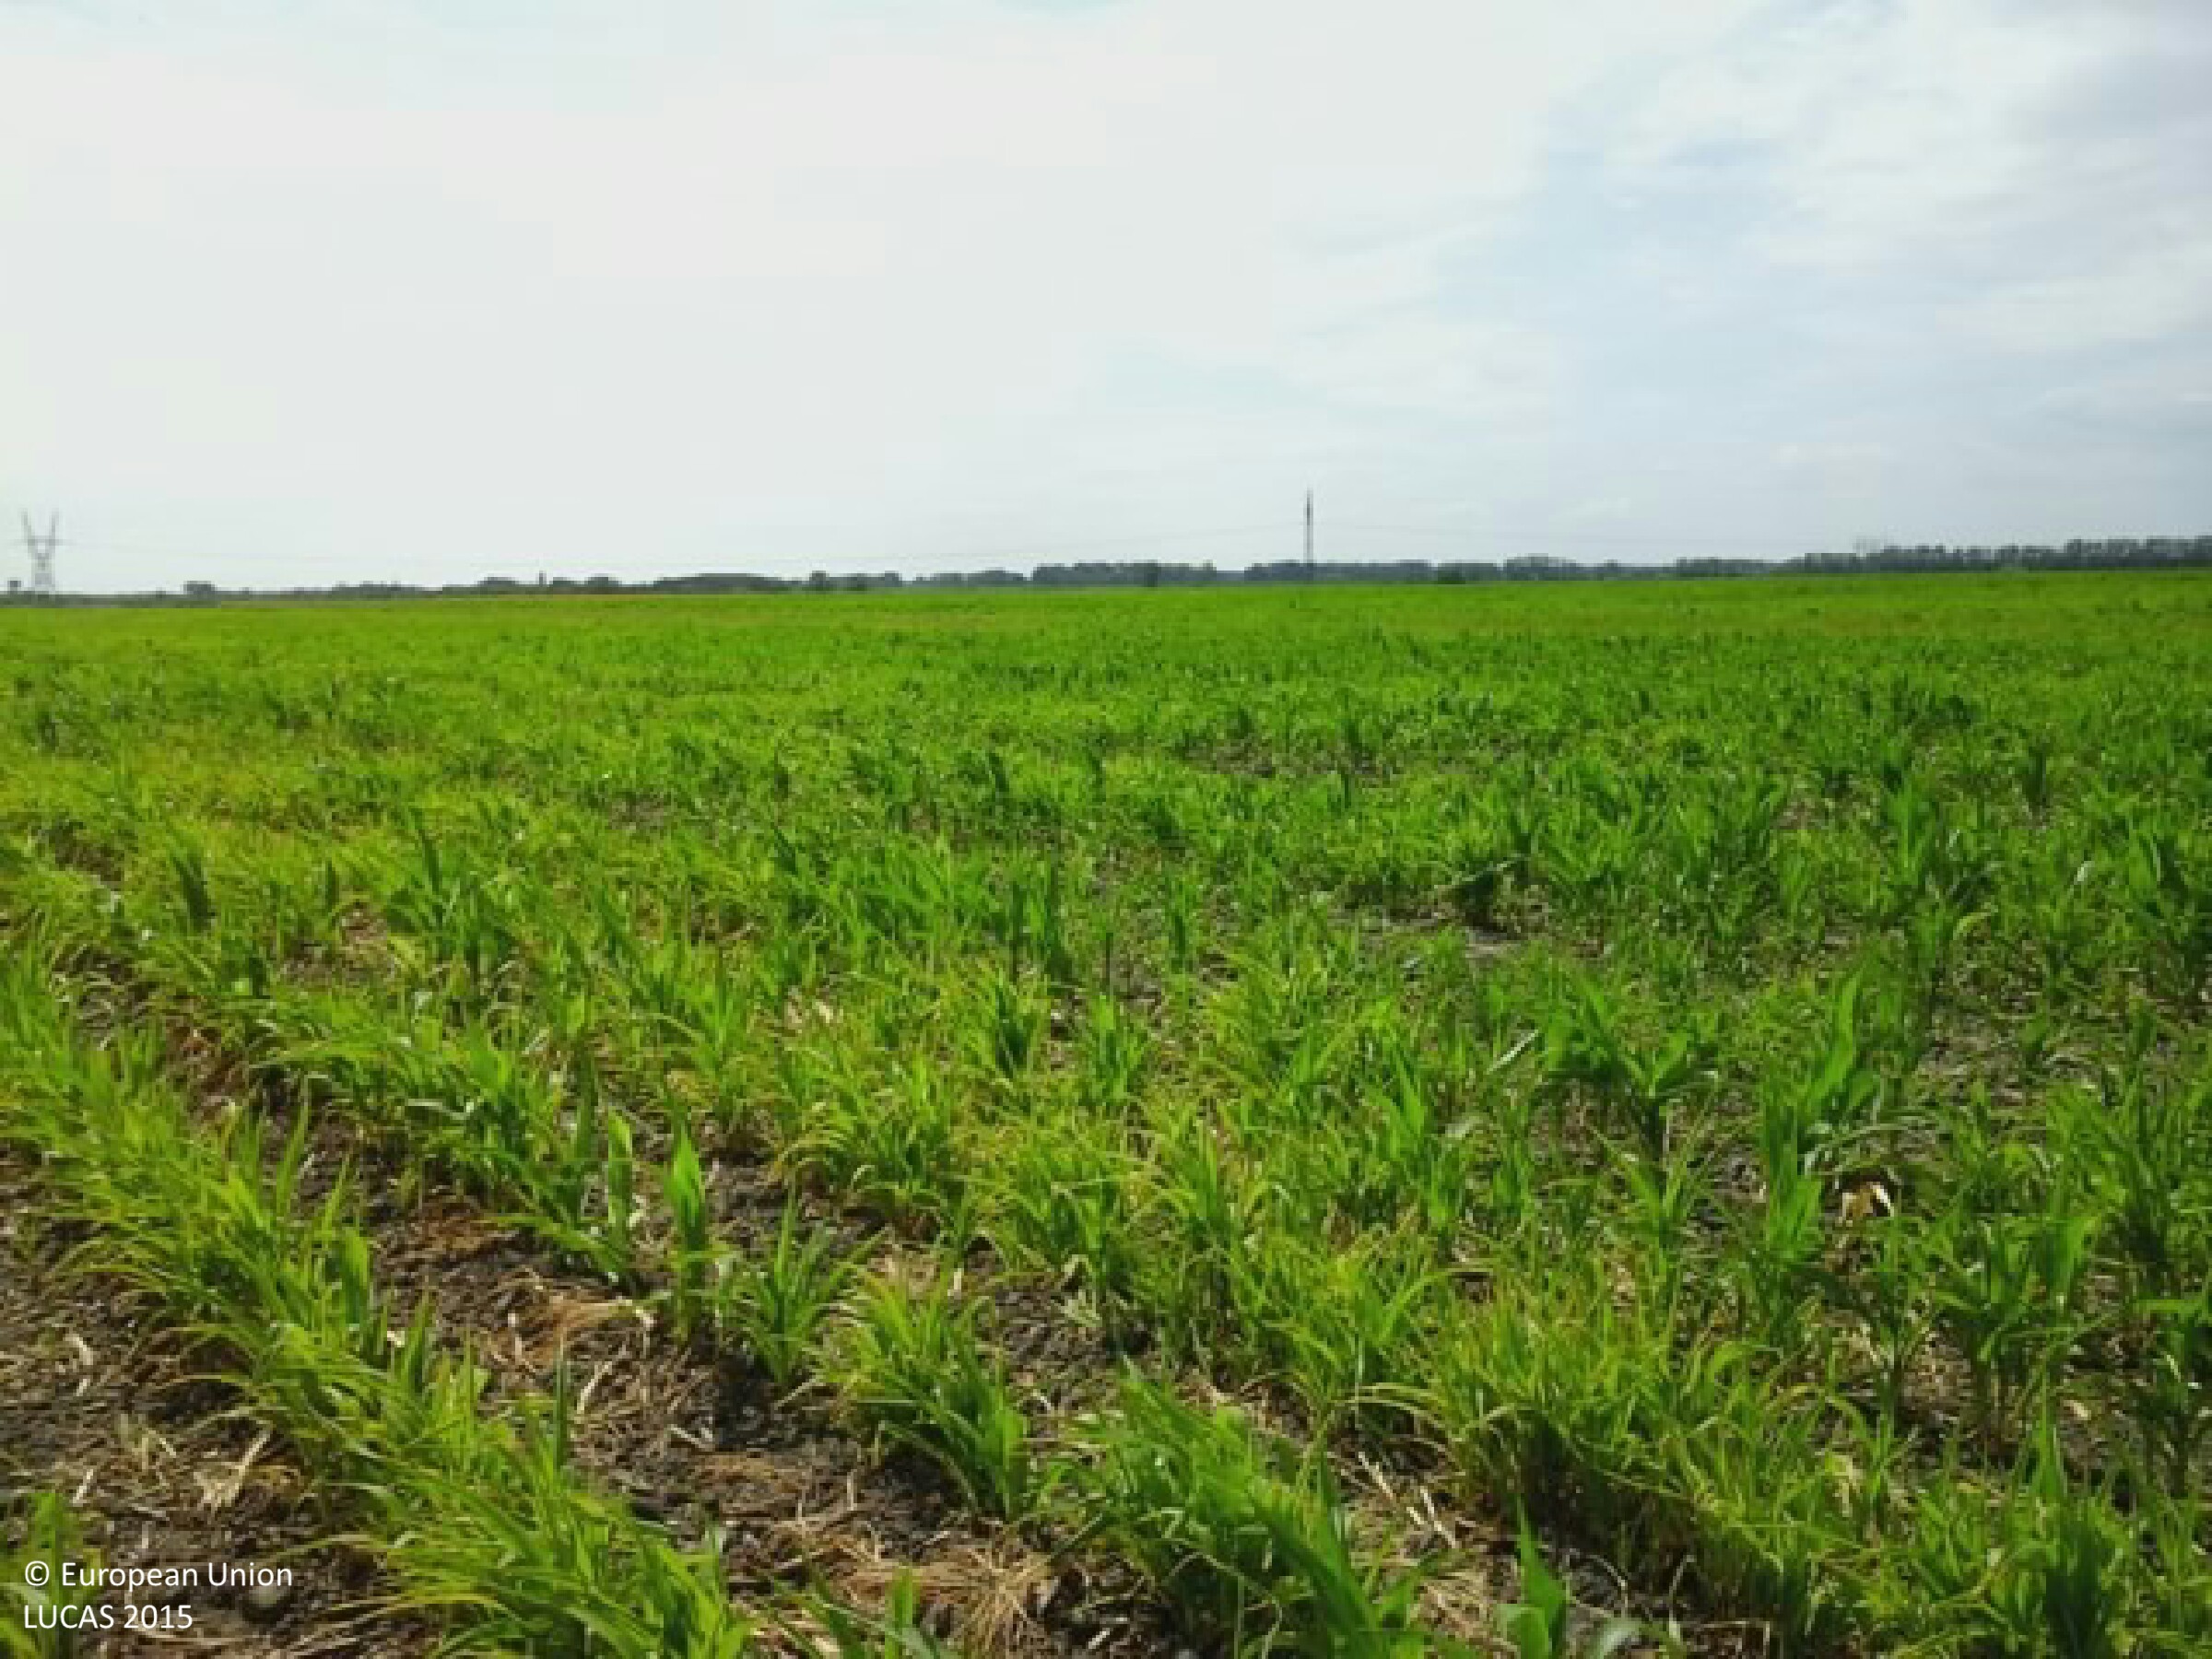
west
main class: Cropland
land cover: Maize
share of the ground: 50 - 75 %
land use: Agriculture (excluding fallow land and kitchen gardens)
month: July
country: HU
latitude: 47.1088
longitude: 19.0431
